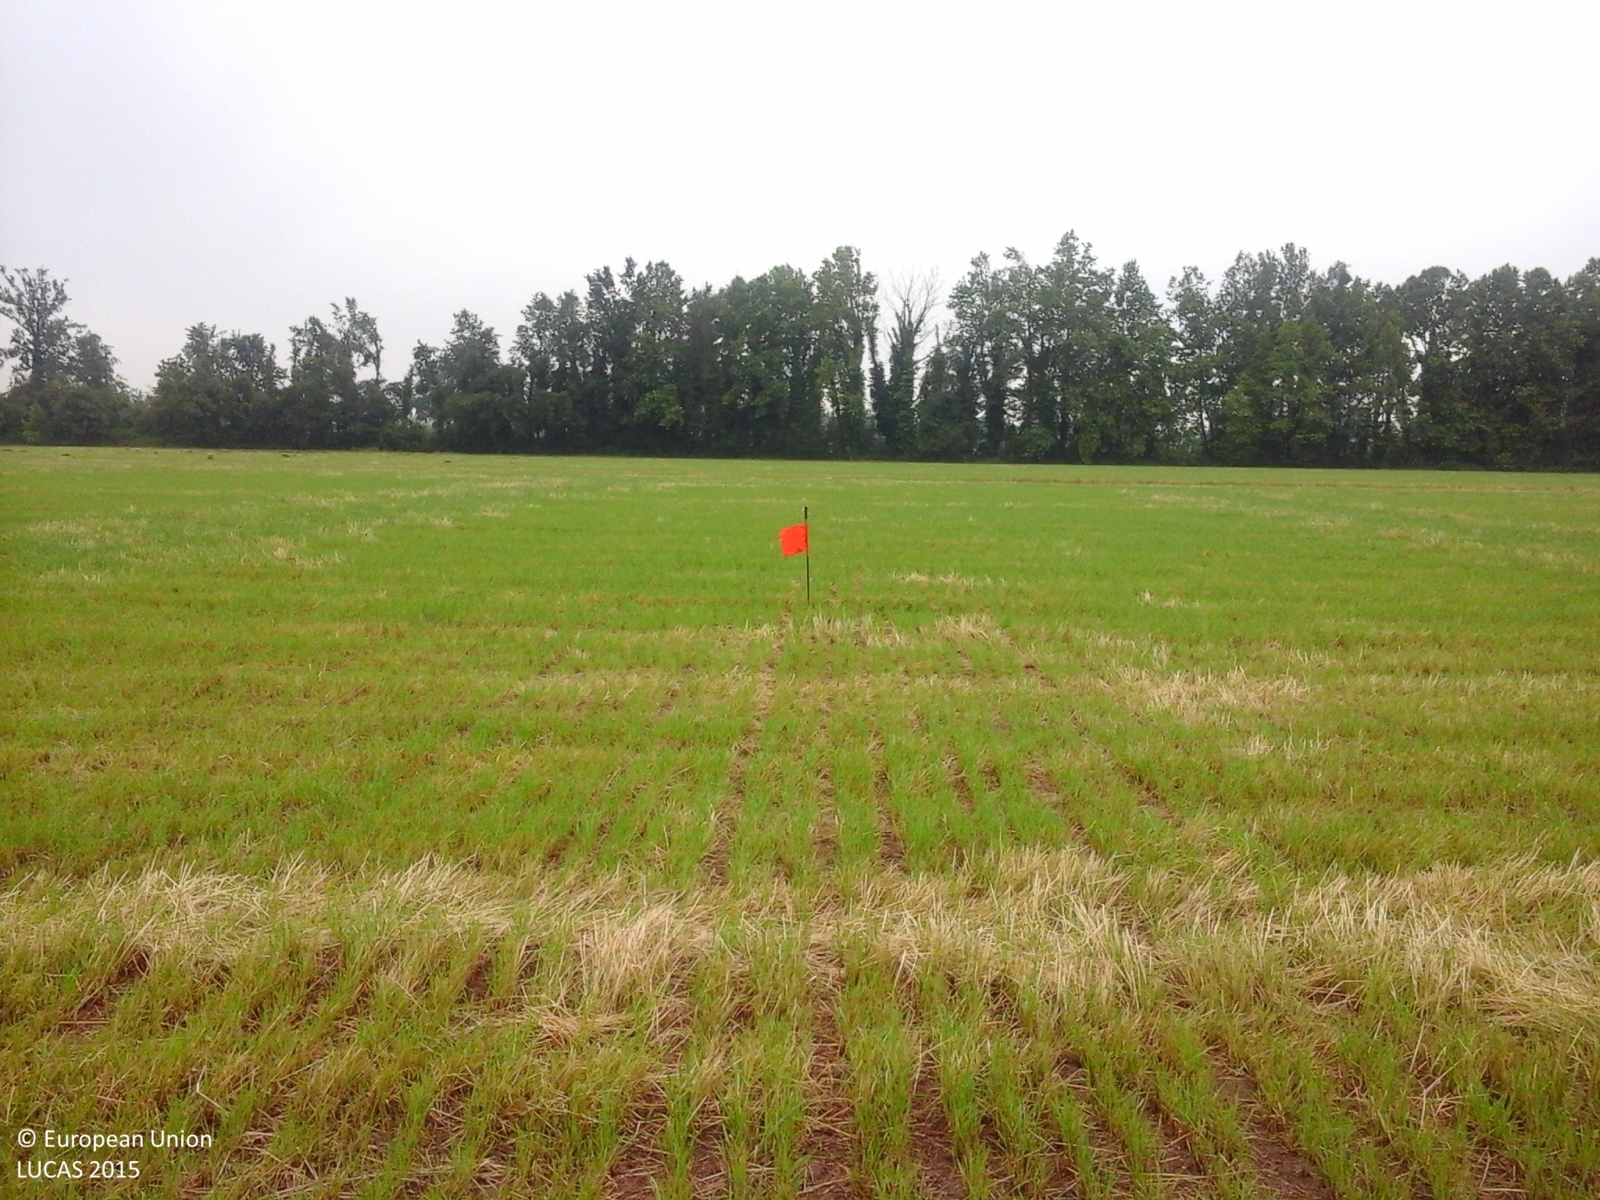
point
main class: Cropland
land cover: Temporary grasslands
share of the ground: > 75 %
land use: Agriculture (excluding fallow land and kitchen gardens)
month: May
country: IT
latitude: 45.2160
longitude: 10.0635
